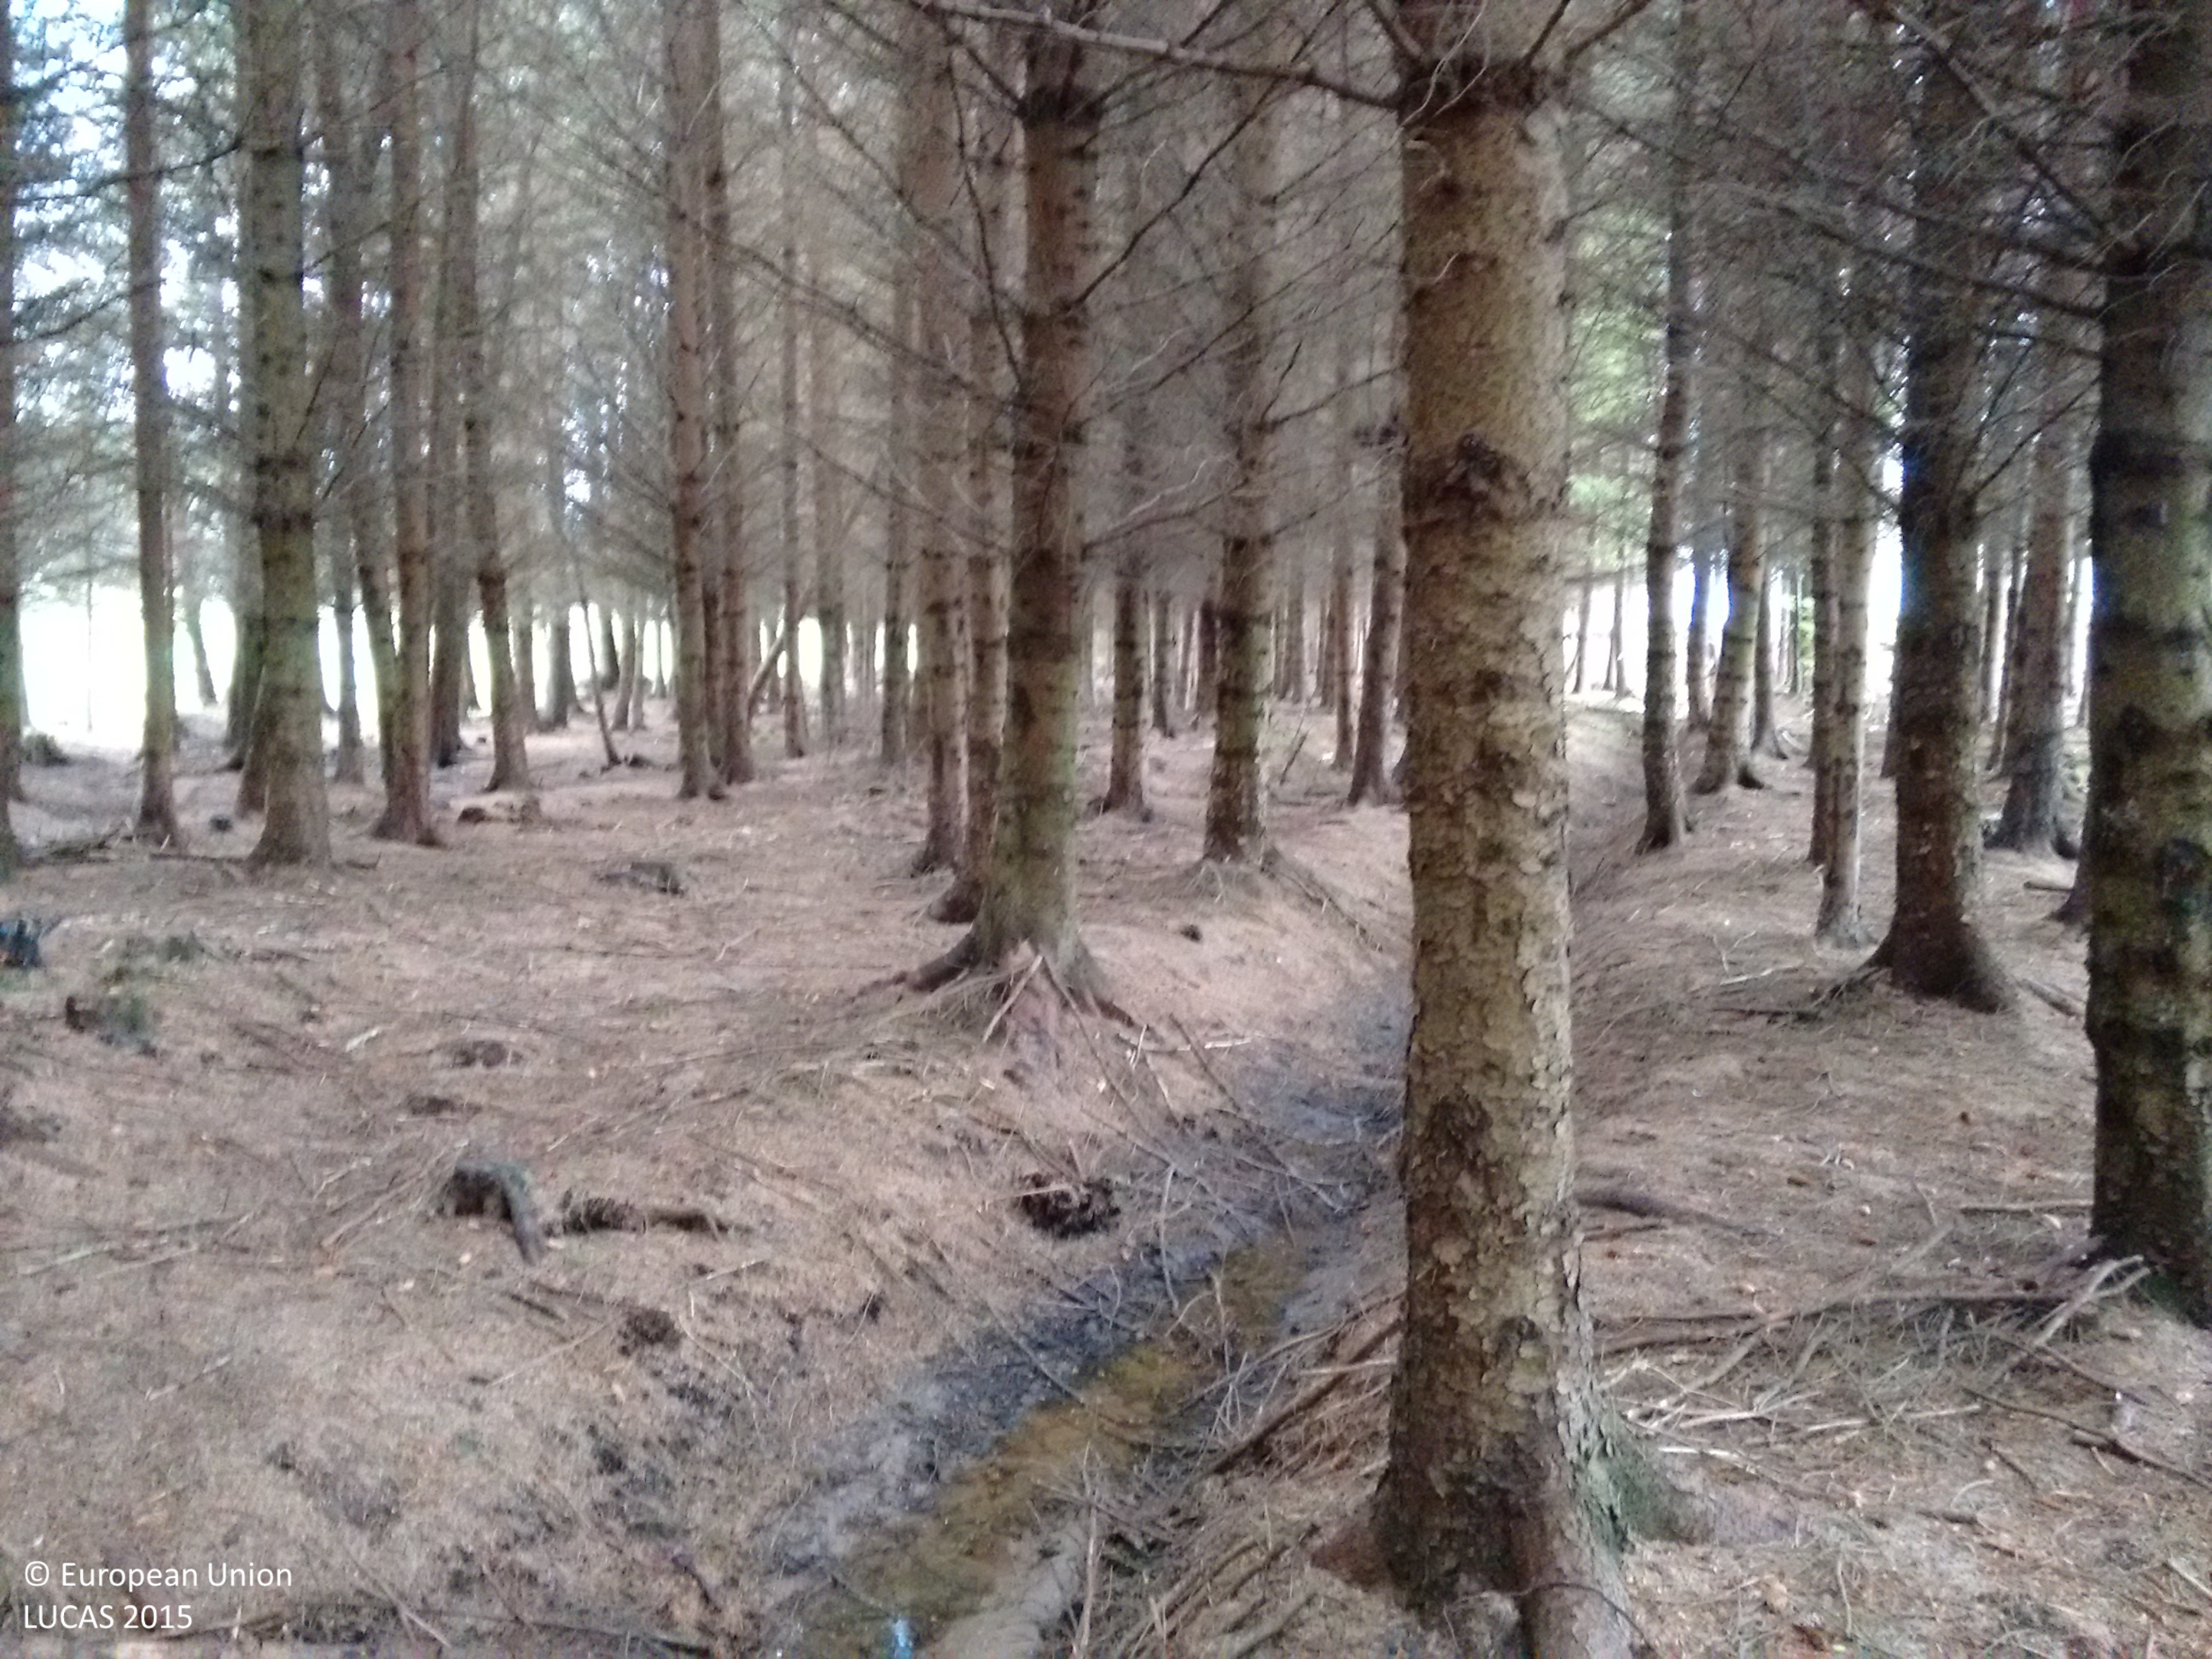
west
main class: Woodland
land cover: Spruce dominated coniferous woodland
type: exotic forest
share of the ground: > 75 %
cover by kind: coniferous forest trees 95 %, unconsolidated bare surface 5 %
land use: Forestry
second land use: Amenities, museums, leisure
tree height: > 5 m
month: May
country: GB
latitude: 55.8259
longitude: -3.2424
